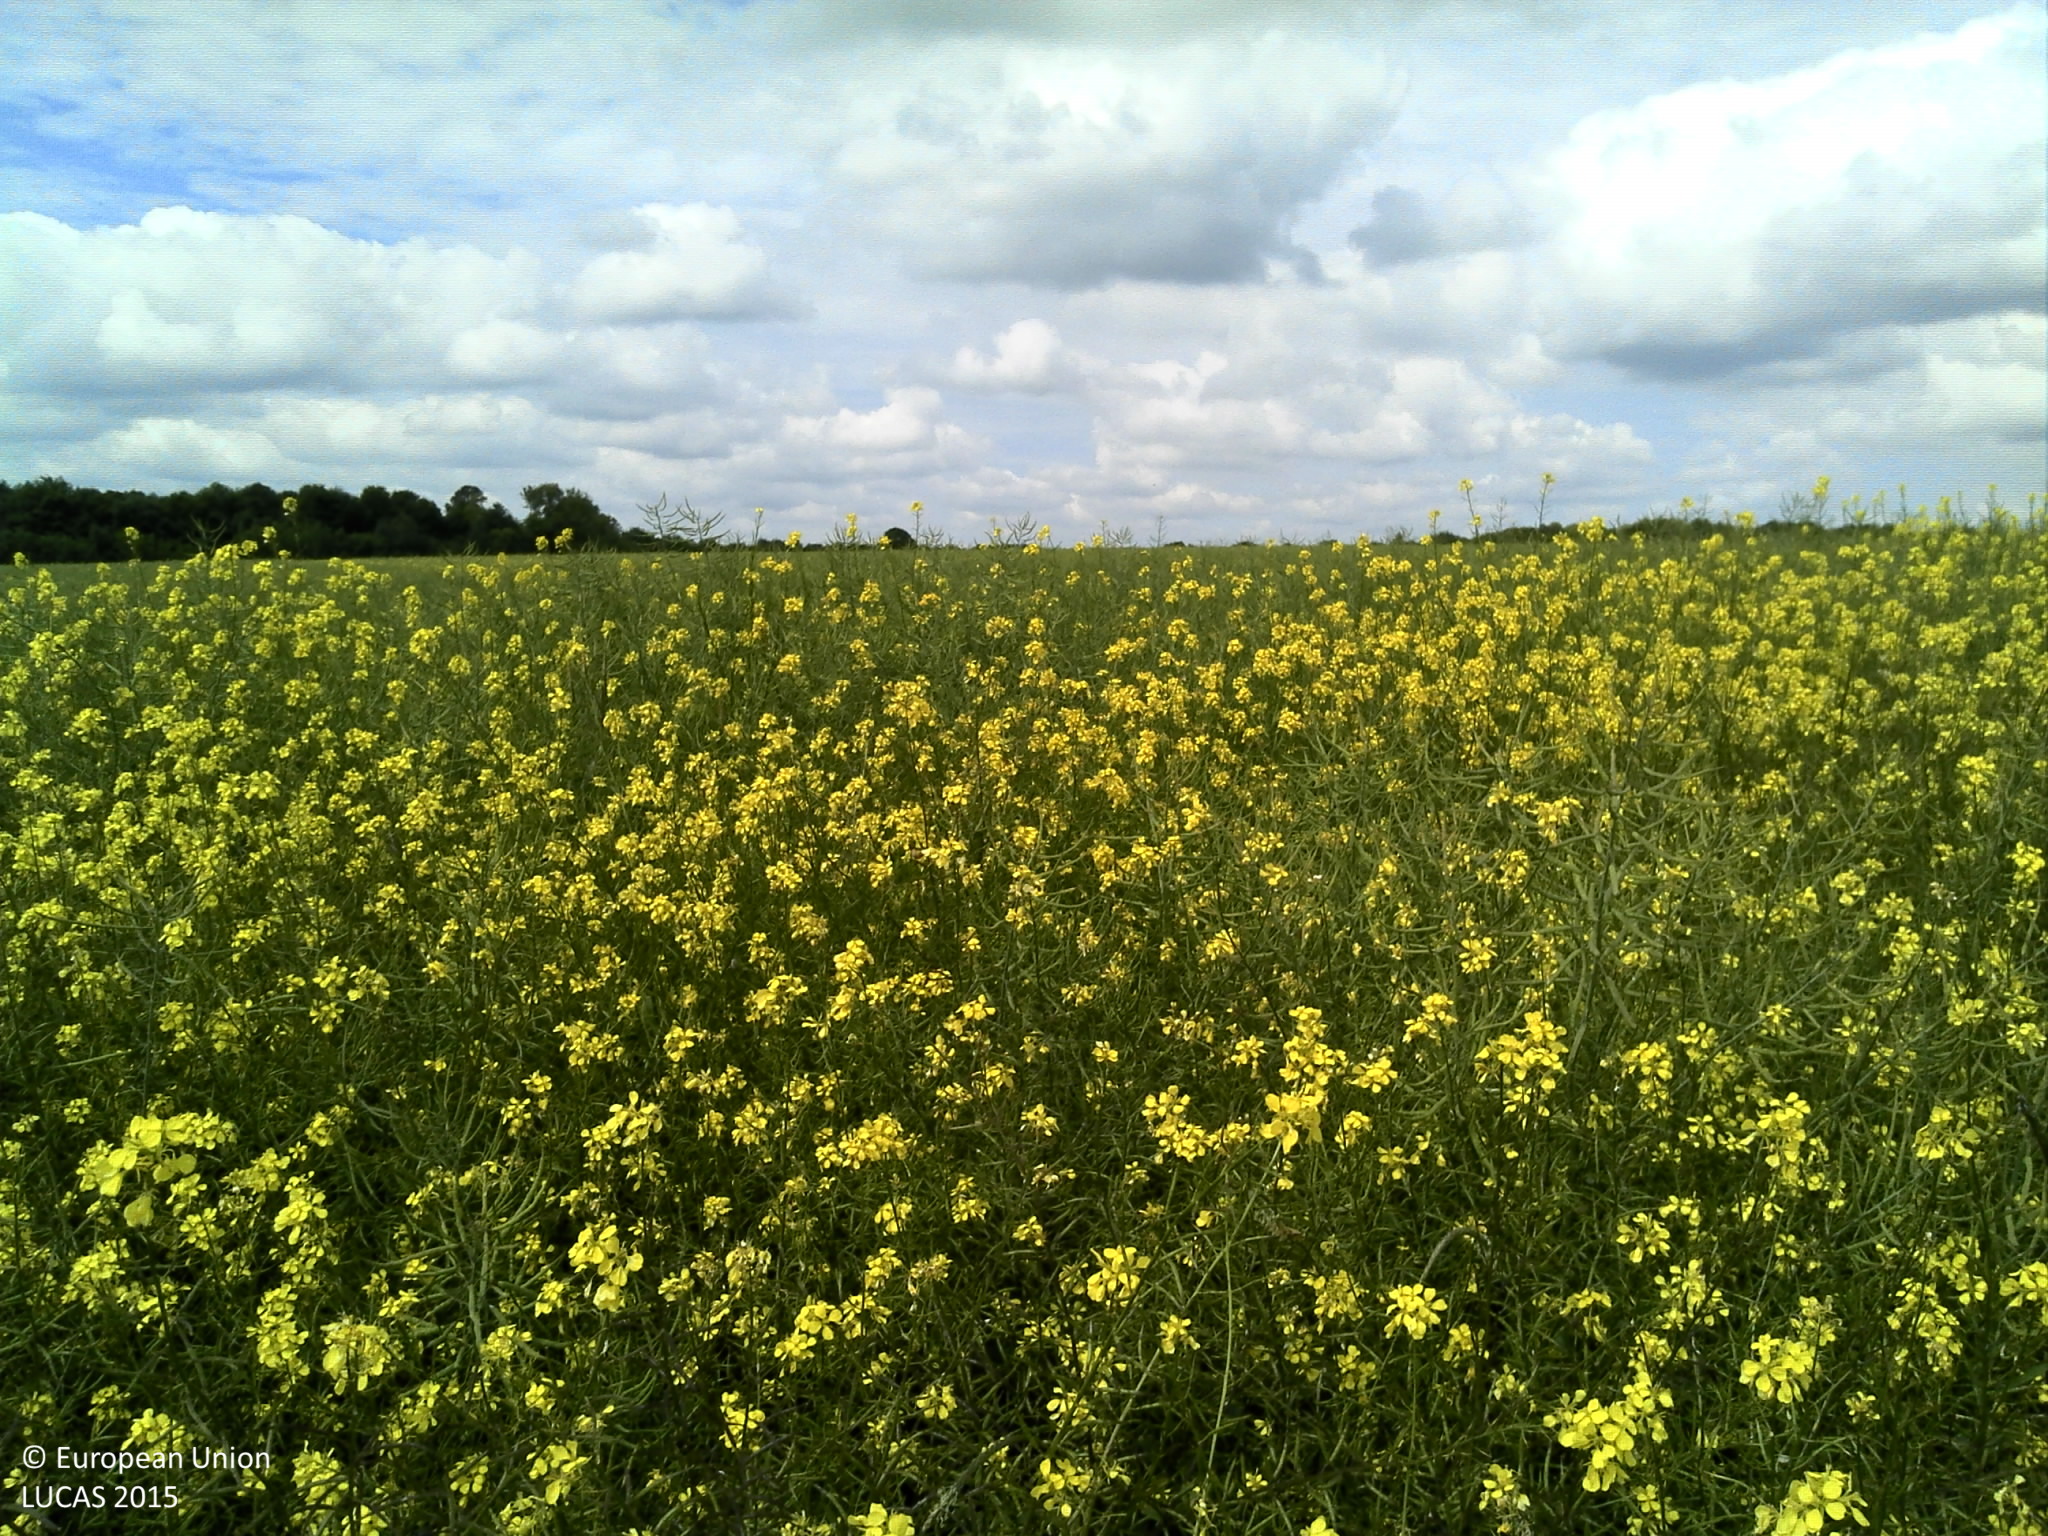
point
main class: Cropland
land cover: Rape and turnip rape
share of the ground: > 75 %
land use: Agriculture (excluding fallow land and kitchen gardens)
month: May
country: FR
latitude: 49.5341
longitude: 1.1772
